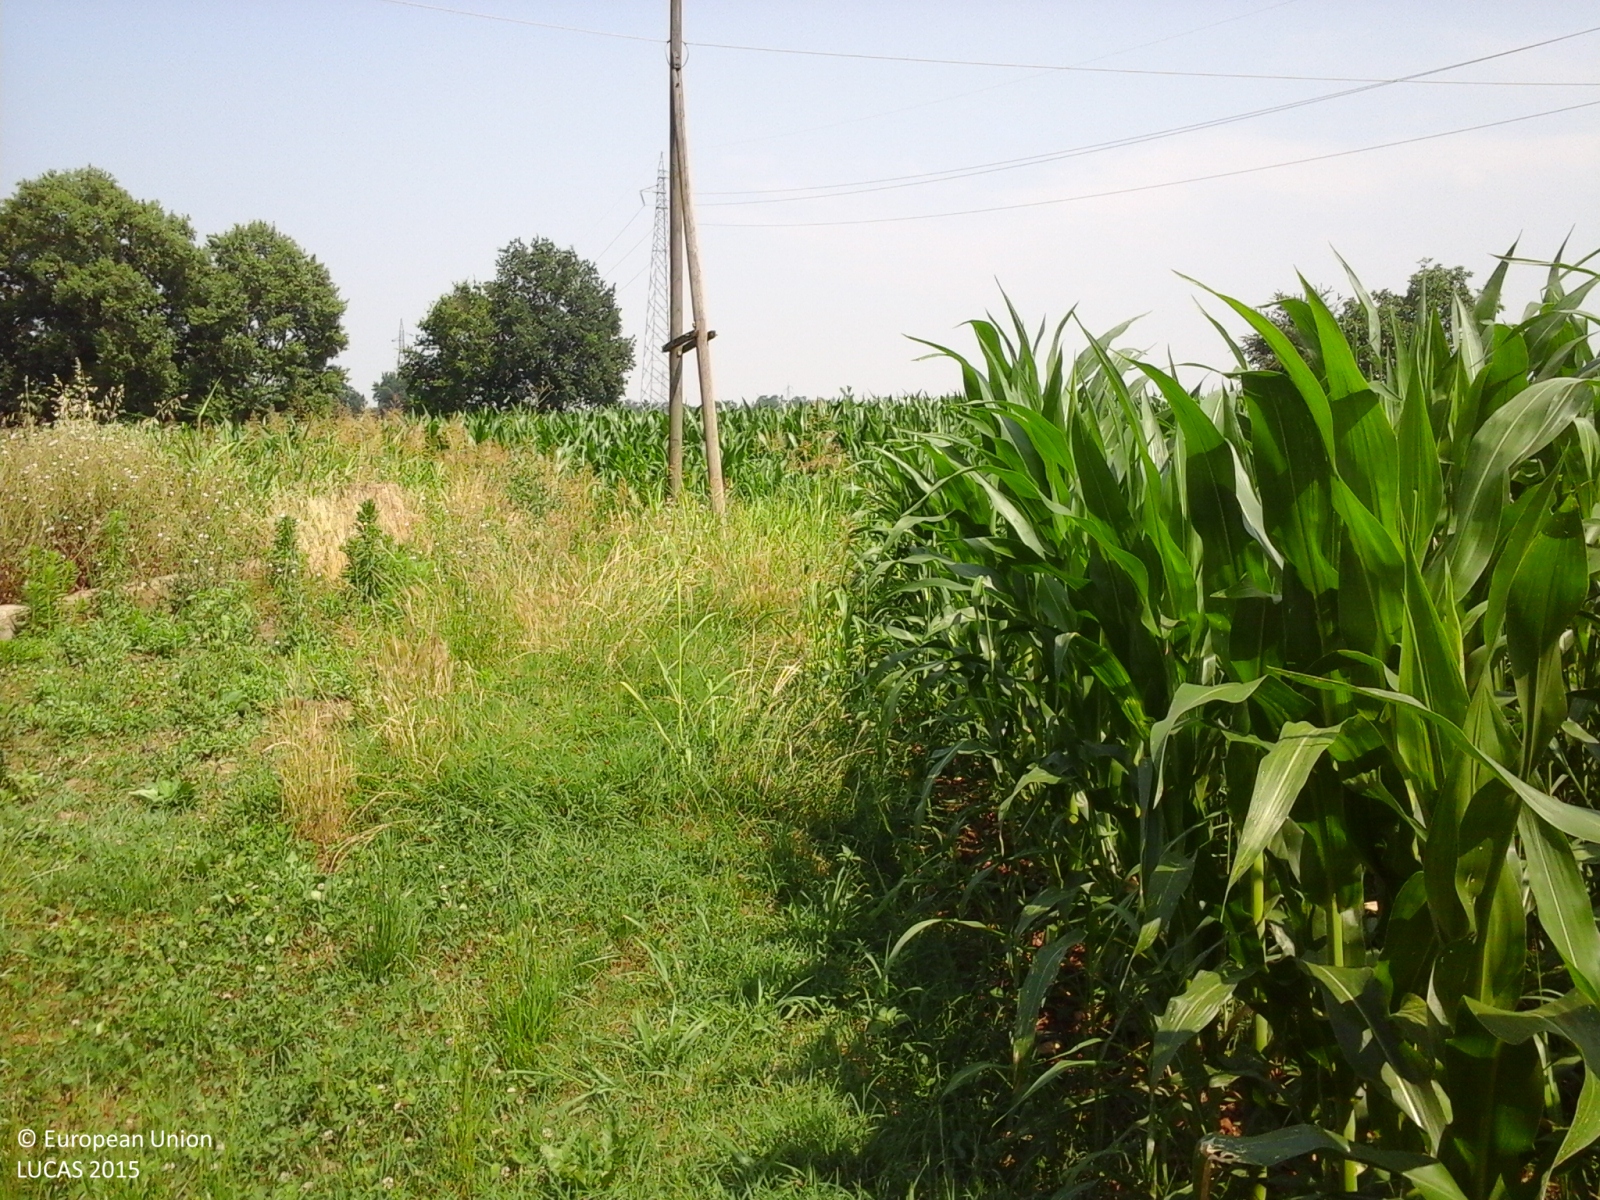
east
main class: Cropland
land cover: Maize
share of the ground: > 75 %
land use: Agriculture (excluding fallow land and kitchen gardens)
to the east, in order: Maize; Managed hedges; Ditches and canals; Tomatoes; Electric lines; Tomatoes
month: June
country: IT
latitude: 44.9095
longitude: 9.9115
